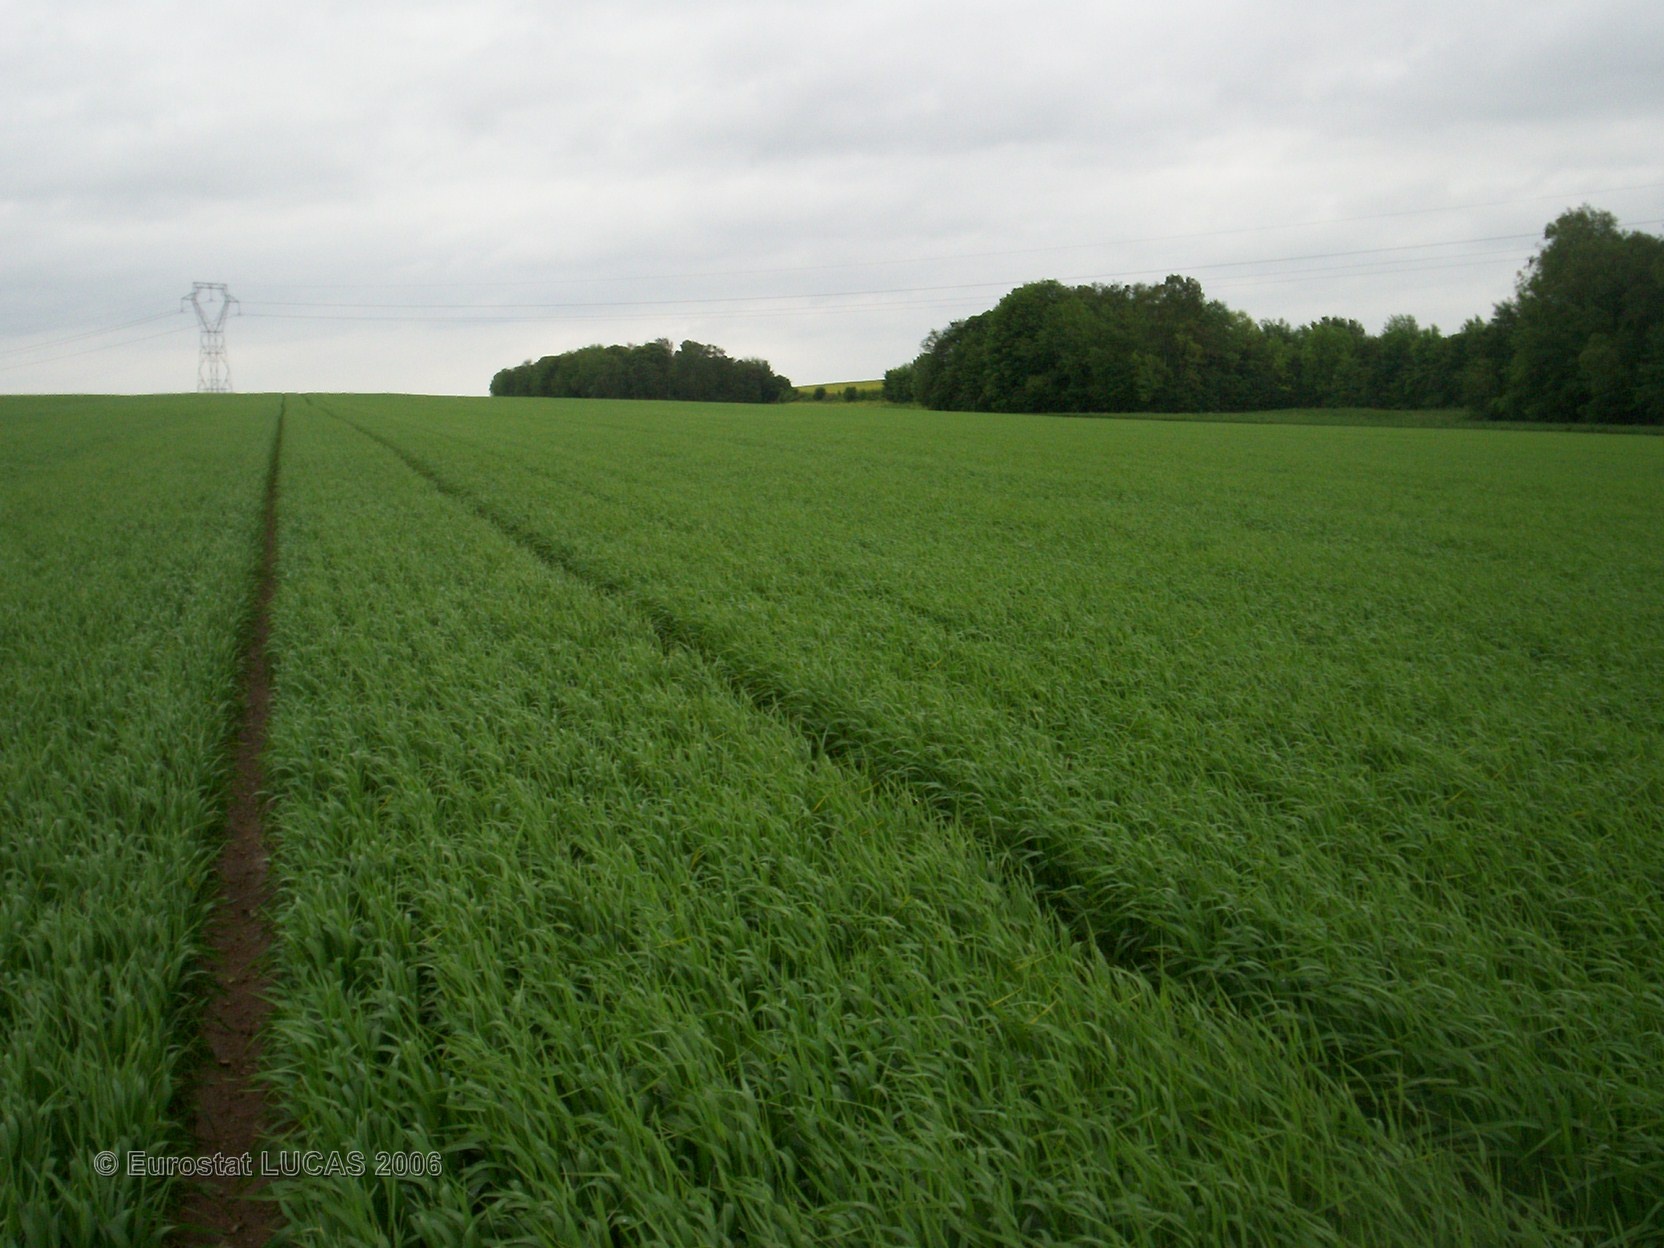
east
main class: Cropland
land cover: Barley
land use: Agriculture (excluding fallow land and kitchen gardens)
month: May
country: FR
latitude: 49.3240
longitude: 4.3688
